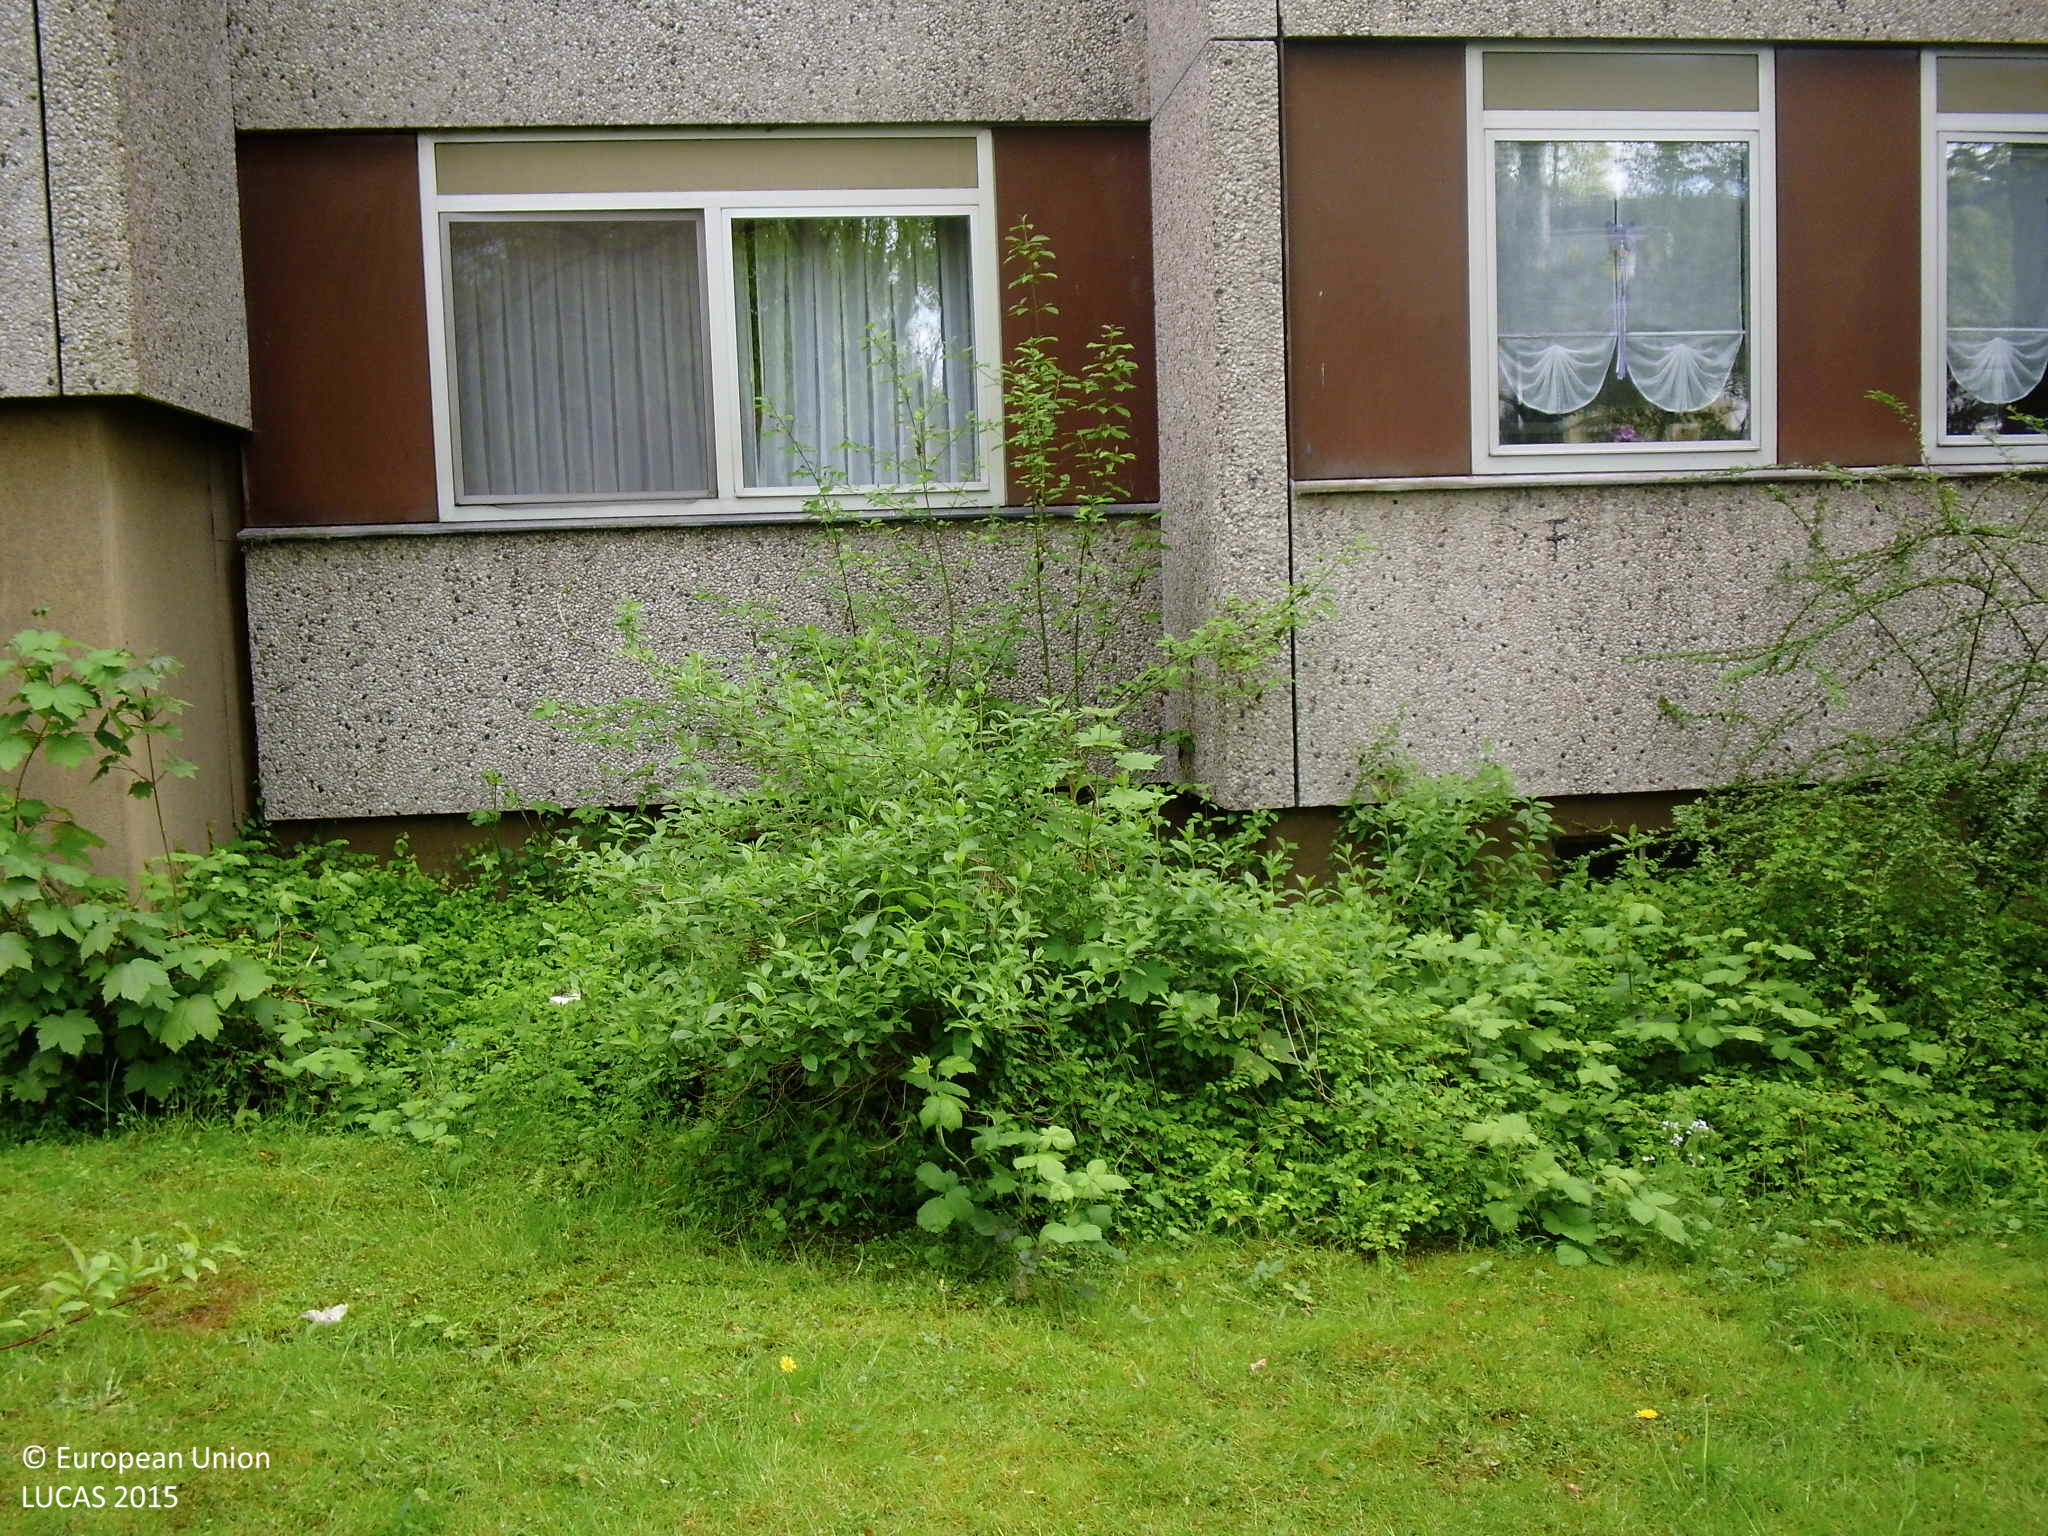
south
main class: Woodland
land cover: Broadleaved woodland
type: mesophytic deciduous forest
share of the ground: > 75 %
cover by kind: broadleaved forest trees 75 %, shrubs 10 %, herbaceous plants 10 %, unconsolidated bare surface 5 %
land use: Residential
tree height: > 5 m
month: May
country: DE
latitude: 51.5575
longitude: 7.3895
